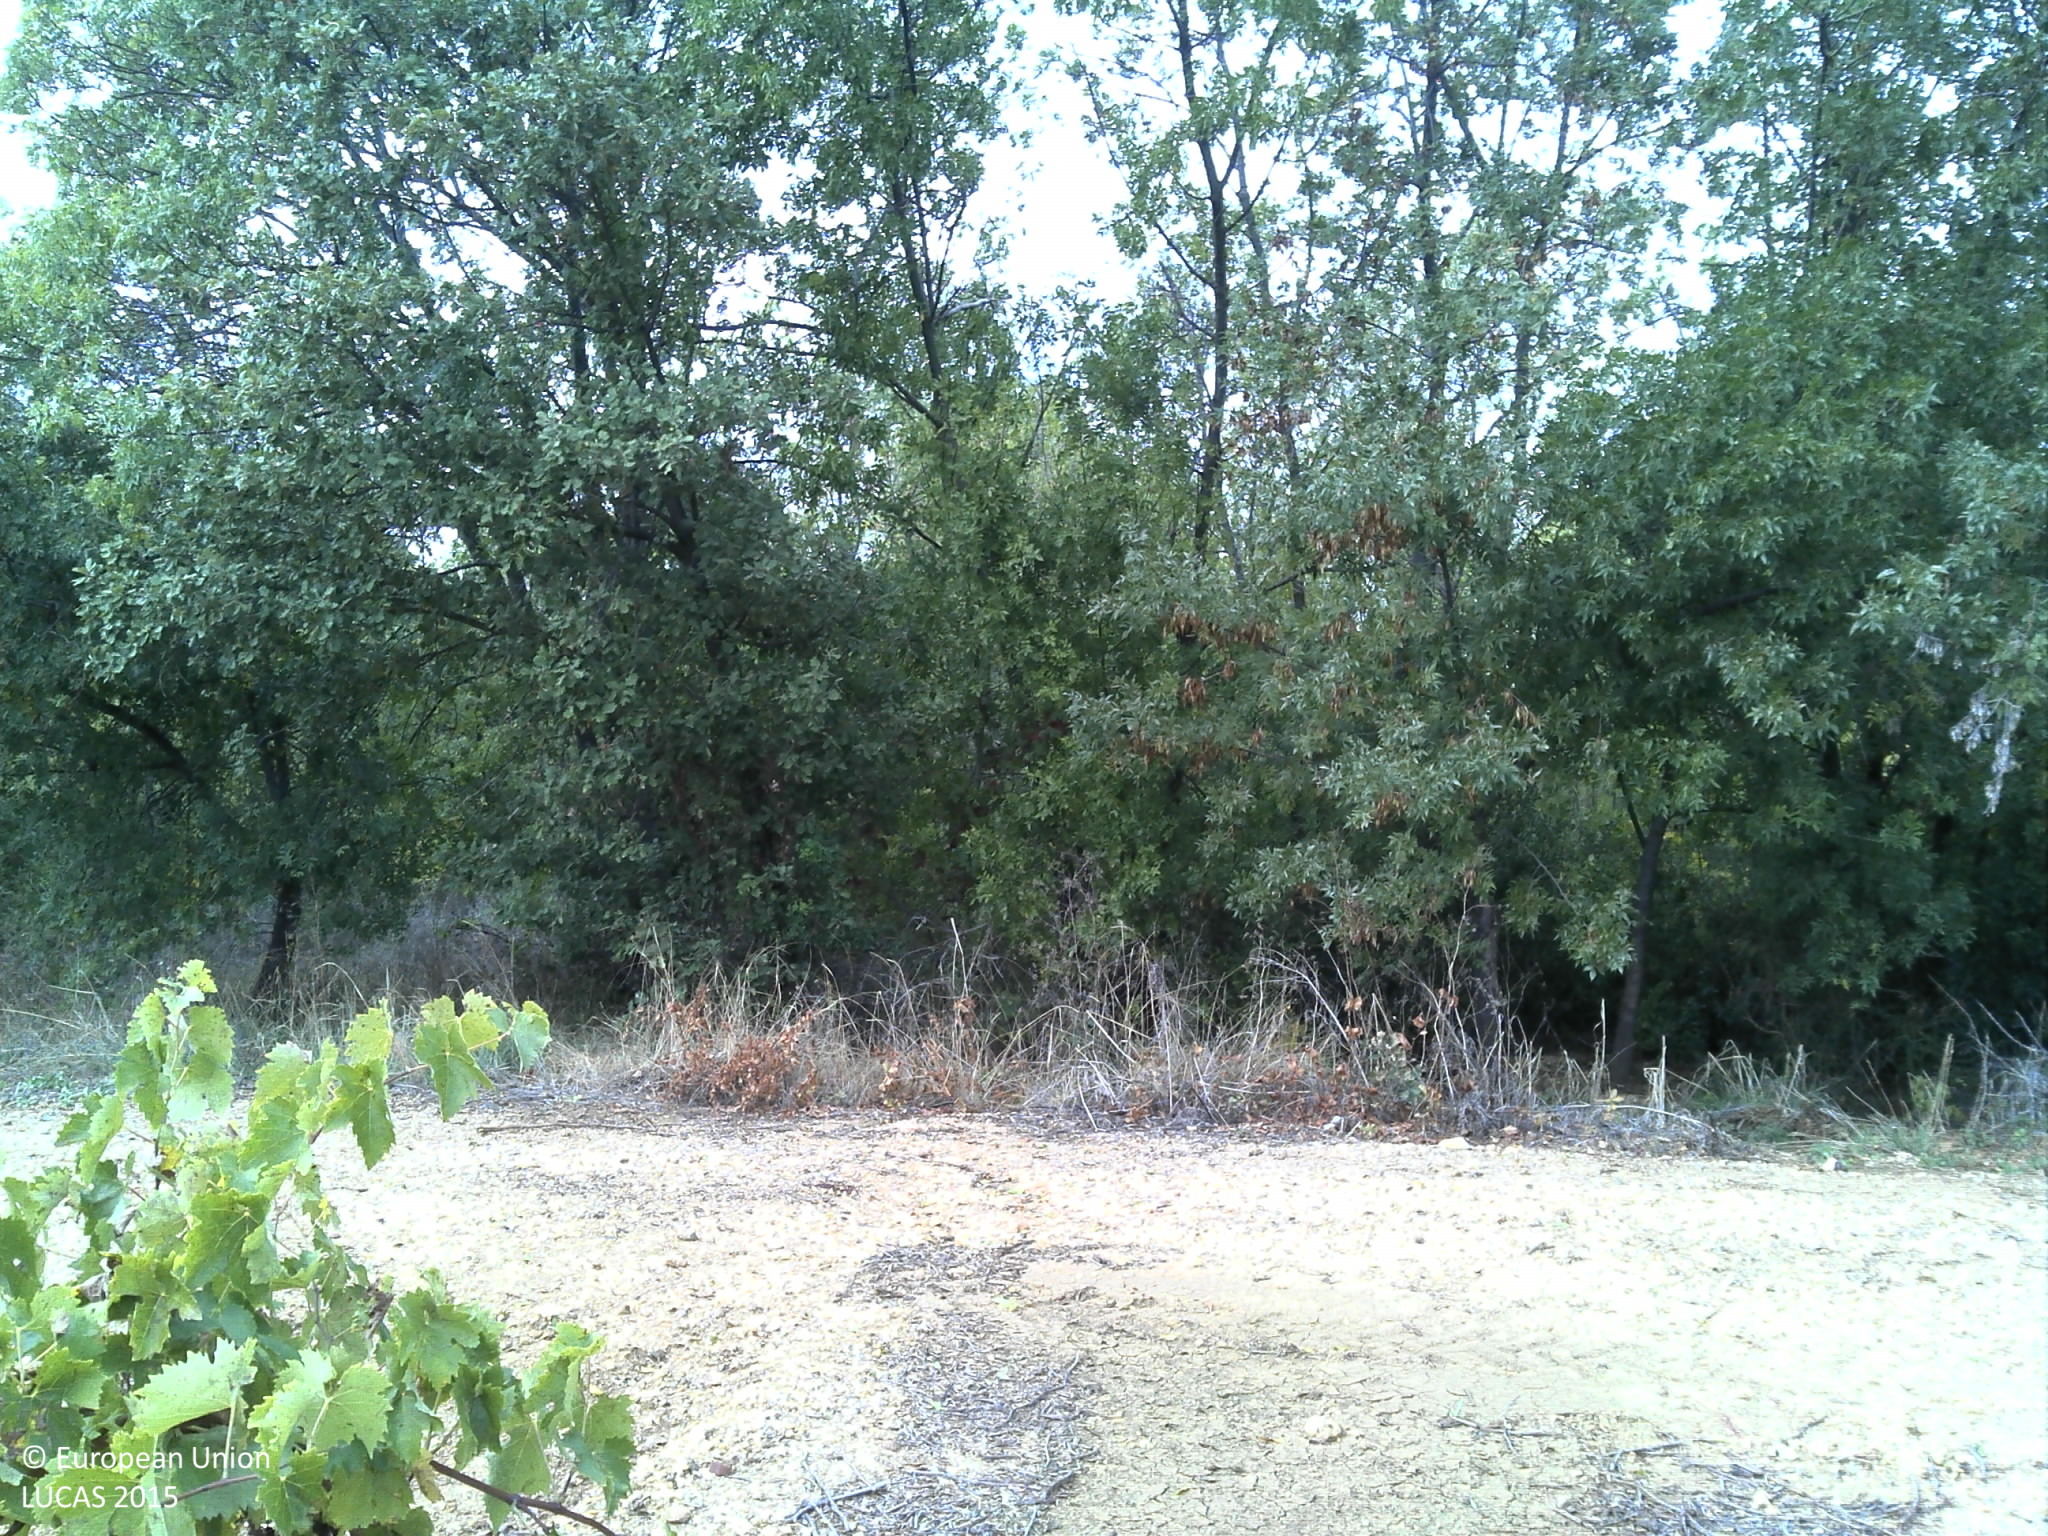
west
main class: Cropland
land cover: Vineyards
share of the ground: 10 - 25 %
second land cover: Other bare soil
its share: > 75 %
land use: Agriculture (excluding fallow land and kitchen gardens)
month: October
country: FR
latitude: 43.4298
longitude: 3.3261
